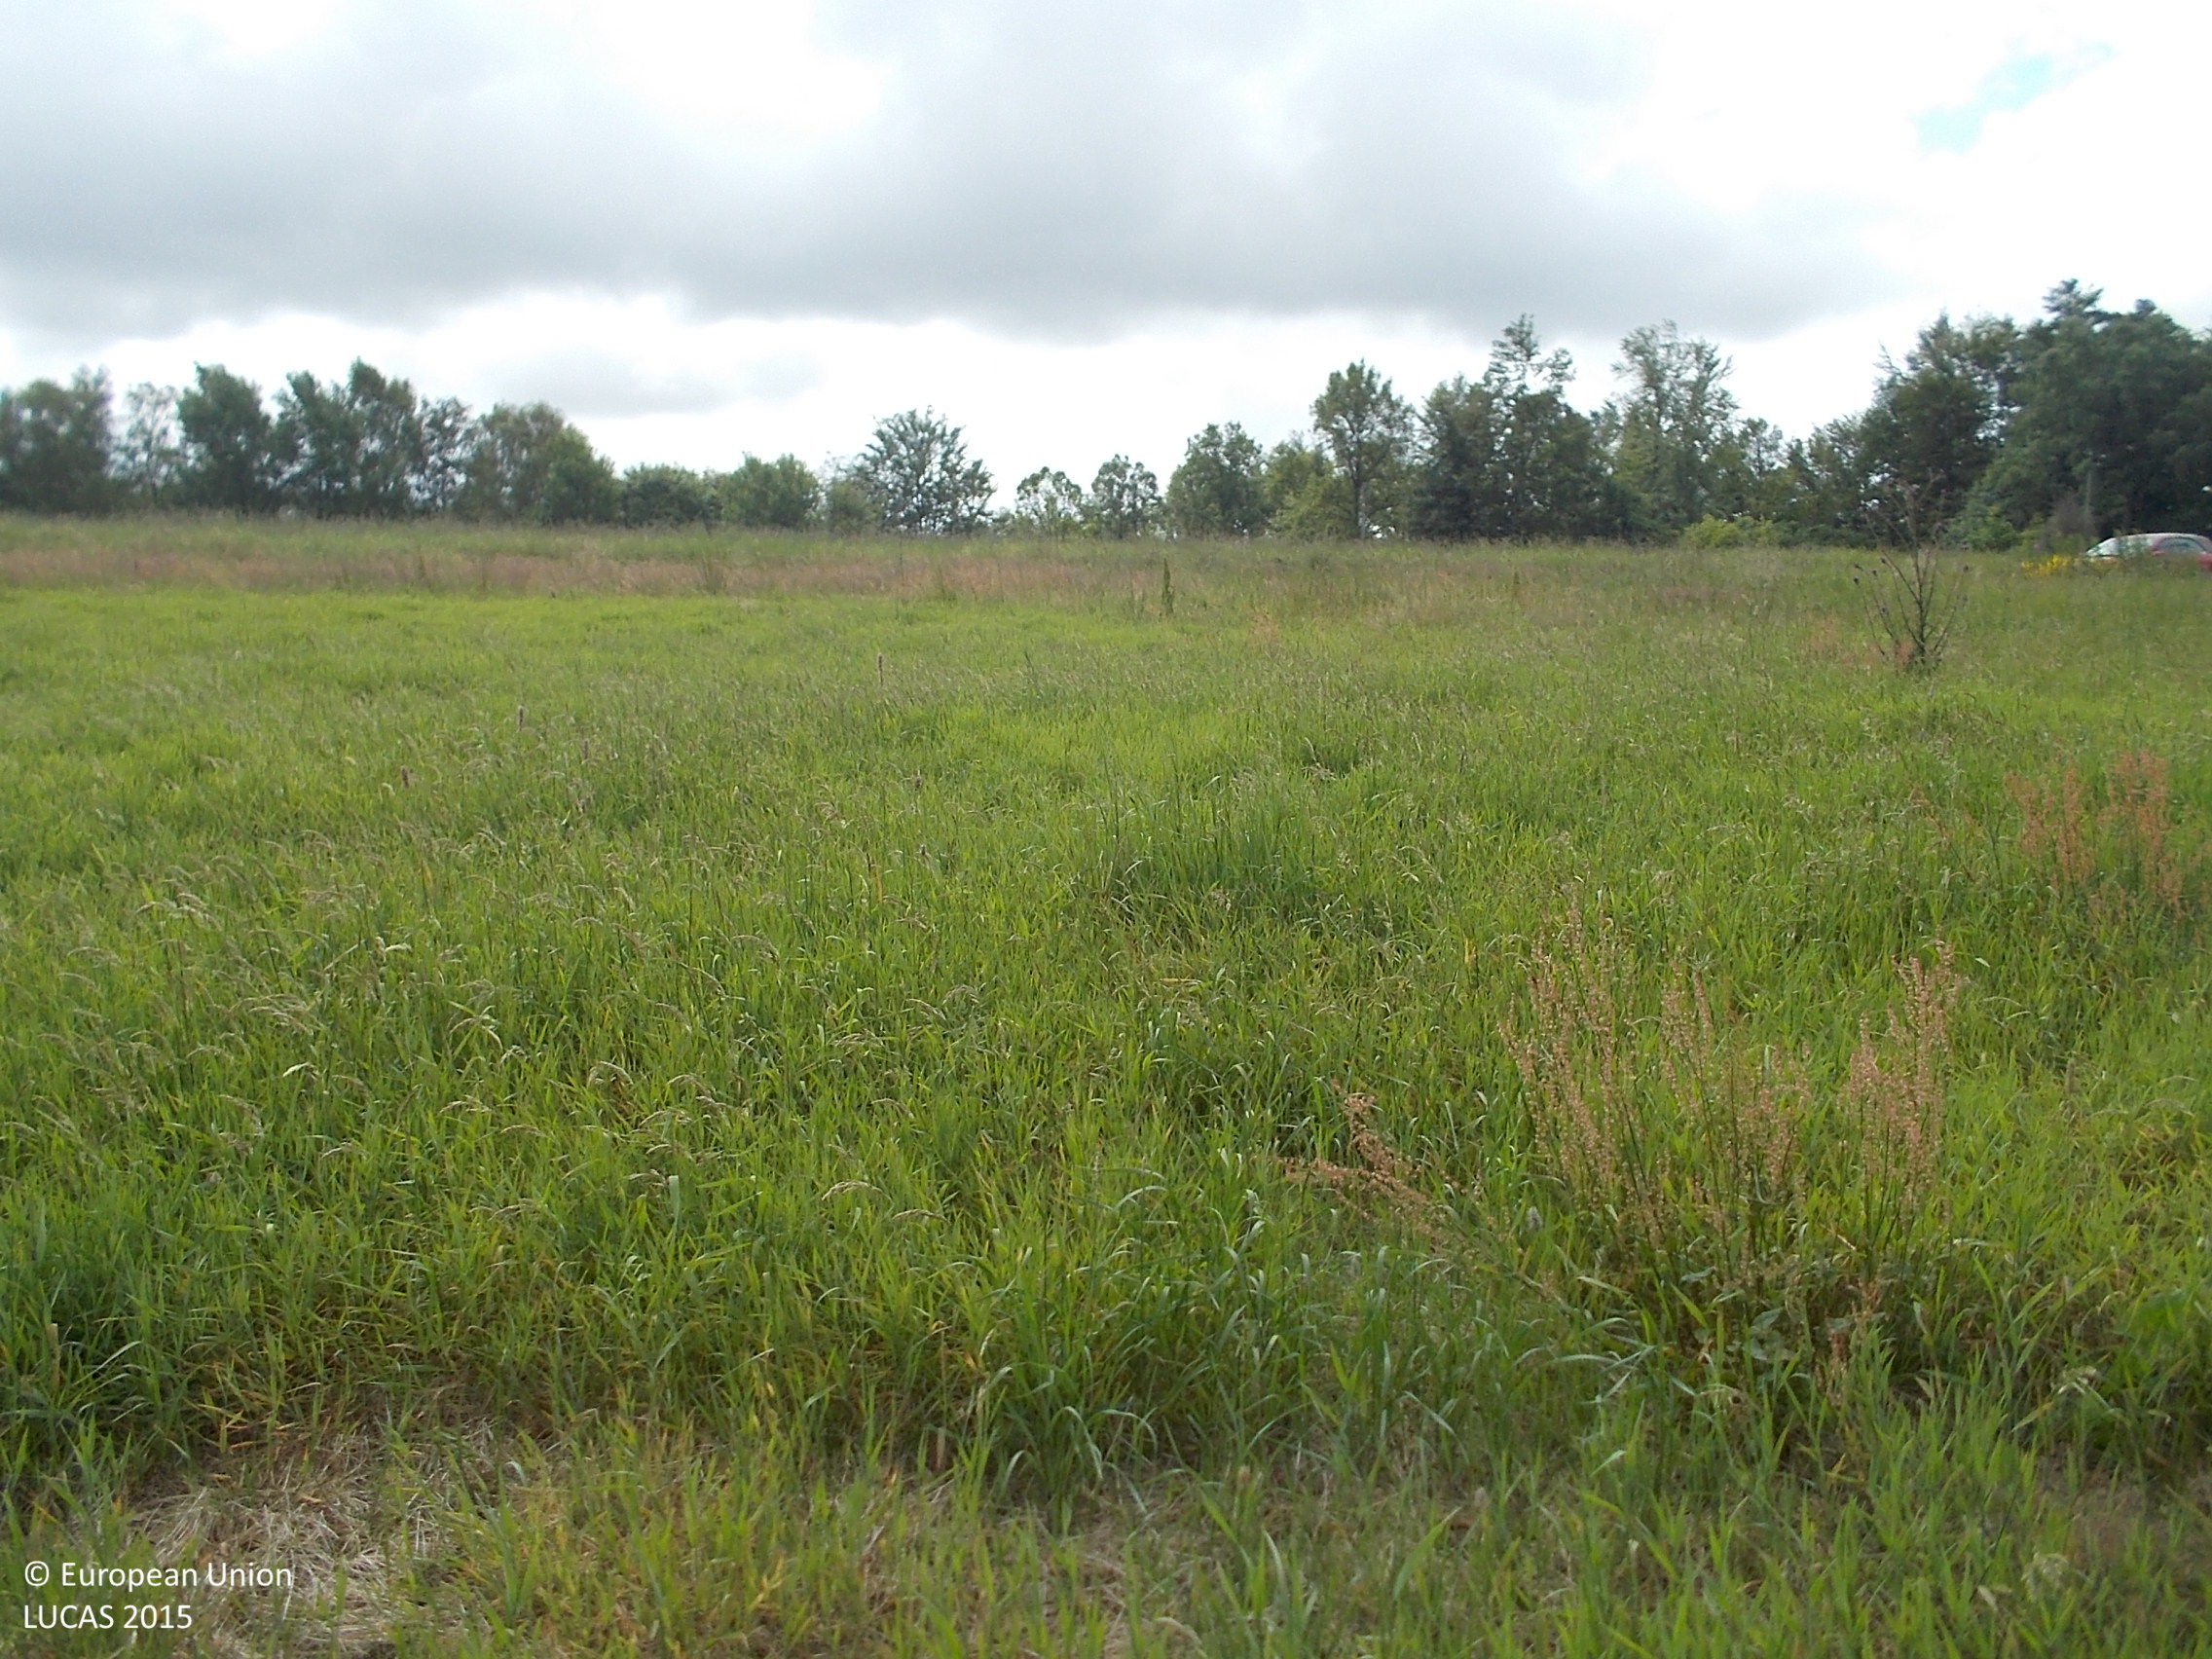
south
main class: Grassland
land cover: Grassland without tree/shrub cover
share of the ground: > 75 %
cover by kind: herbaceous plants 100 %
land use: Agriculture (excluding fallow land and kitchen gardens)
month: July
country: SE
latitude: 57.4266
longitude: 12.2781
